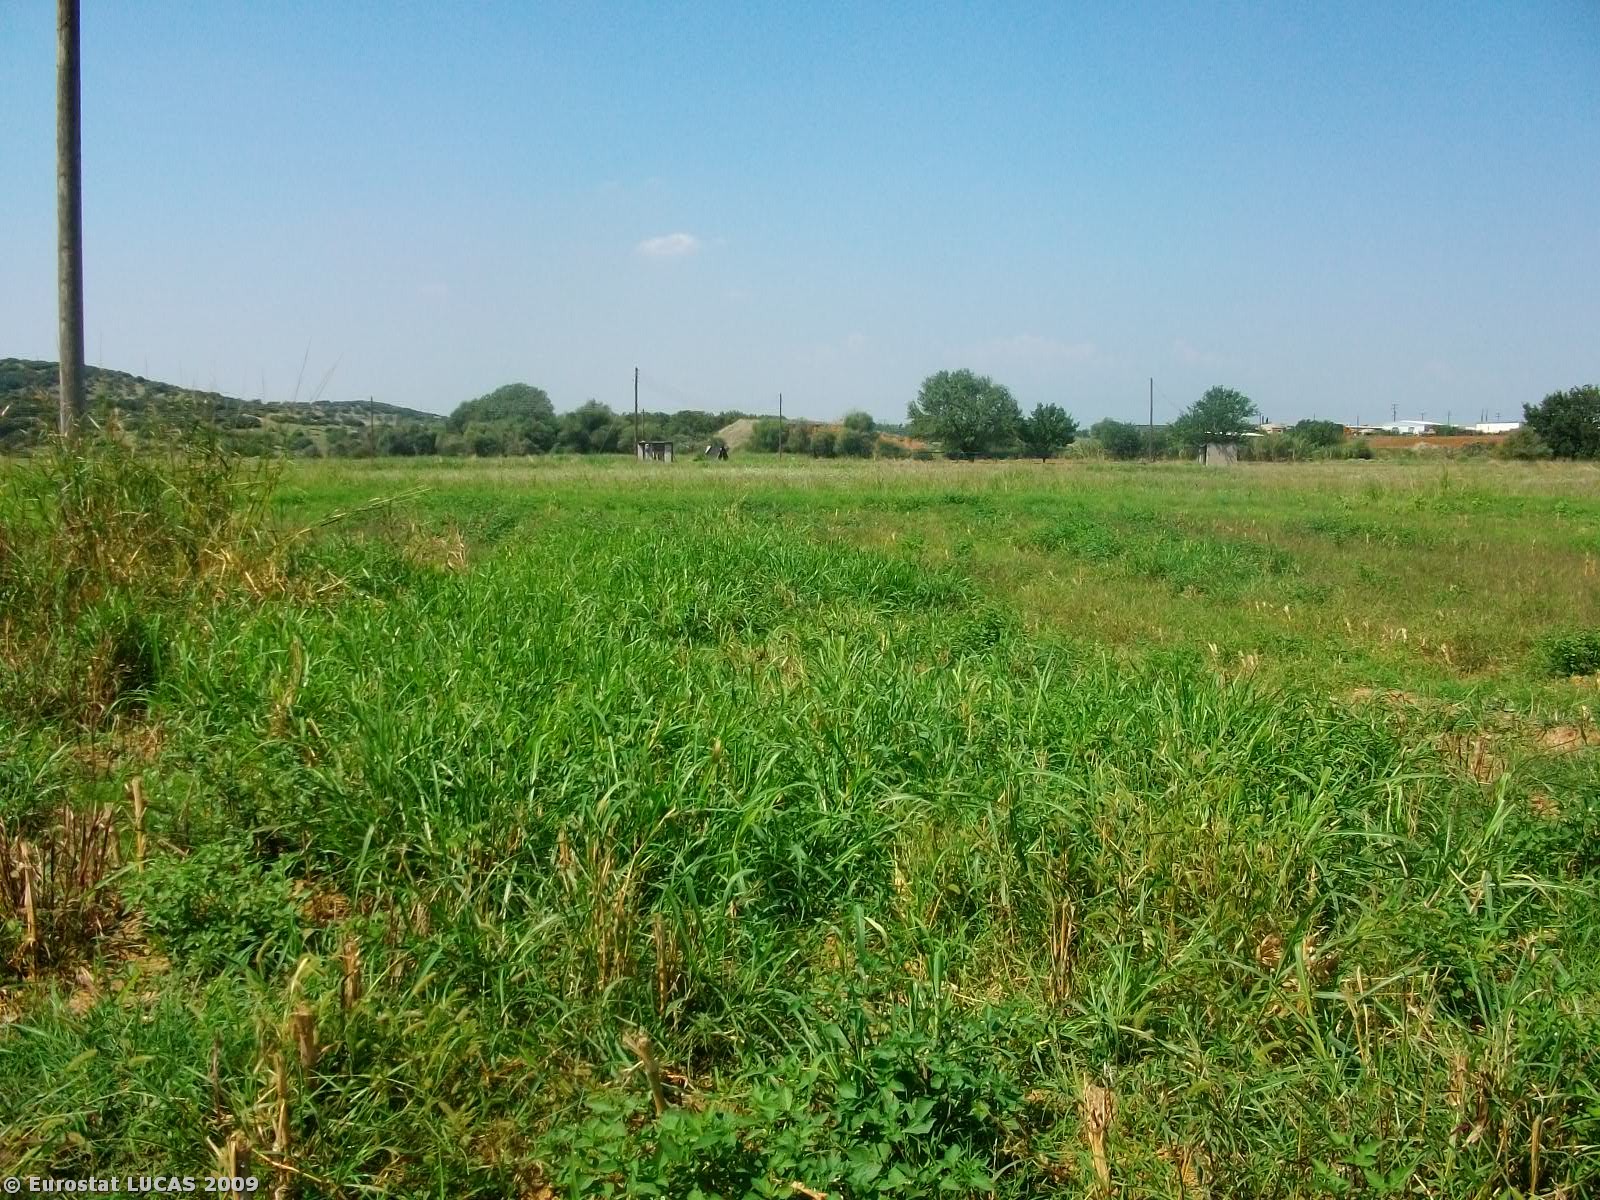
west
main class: Cropland
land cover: Maize
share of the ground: < 10 %
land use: Agriculture (excluding fallow land and kitchen gardens)
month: August
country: GR
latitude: 40.8207
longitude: 22.8967
